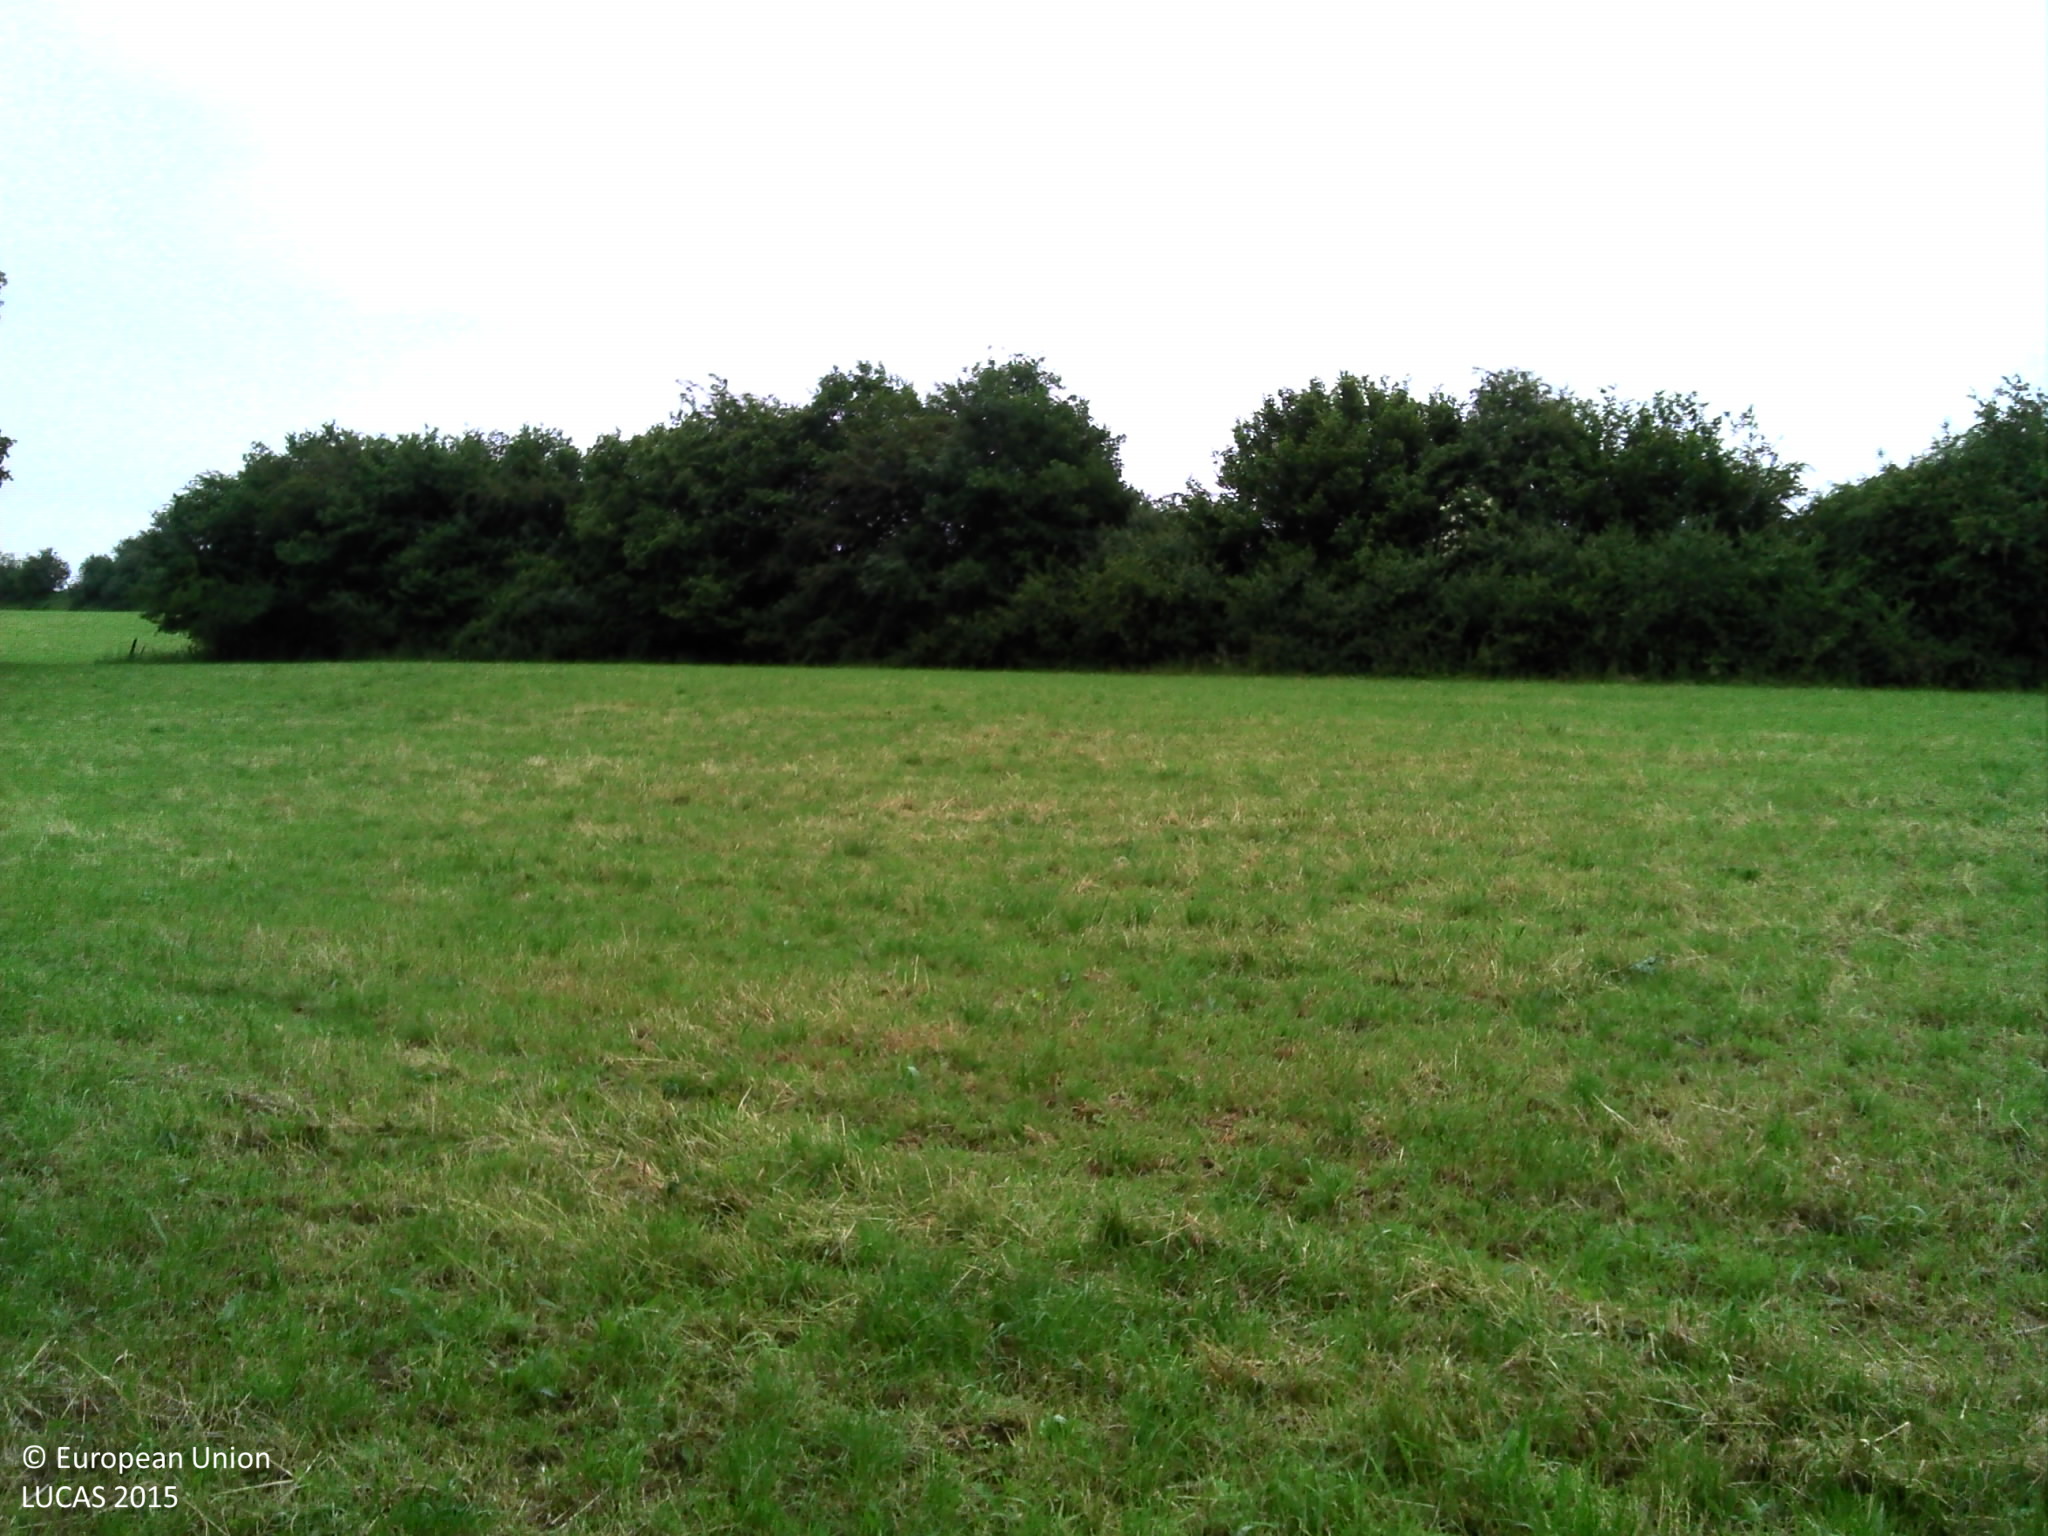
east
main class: Grassland
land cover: Grassland with sparse tree/shrub cover
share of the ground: > 75 %
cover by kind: herbaceous plants 95 %, broadleaved forest trees 5 %
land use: Agriculture (excluding fallow land and kitchen gardens)
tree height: > 5 m
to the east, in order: Abandoned hedges; Grassland without tree/shrub cover; Abandoned hedges; Fences; Grassland without tree/shrub cover; Fences; Grassland without tree/shrub cover
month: June
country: BE
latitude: 50.2966
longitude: 5.5764
